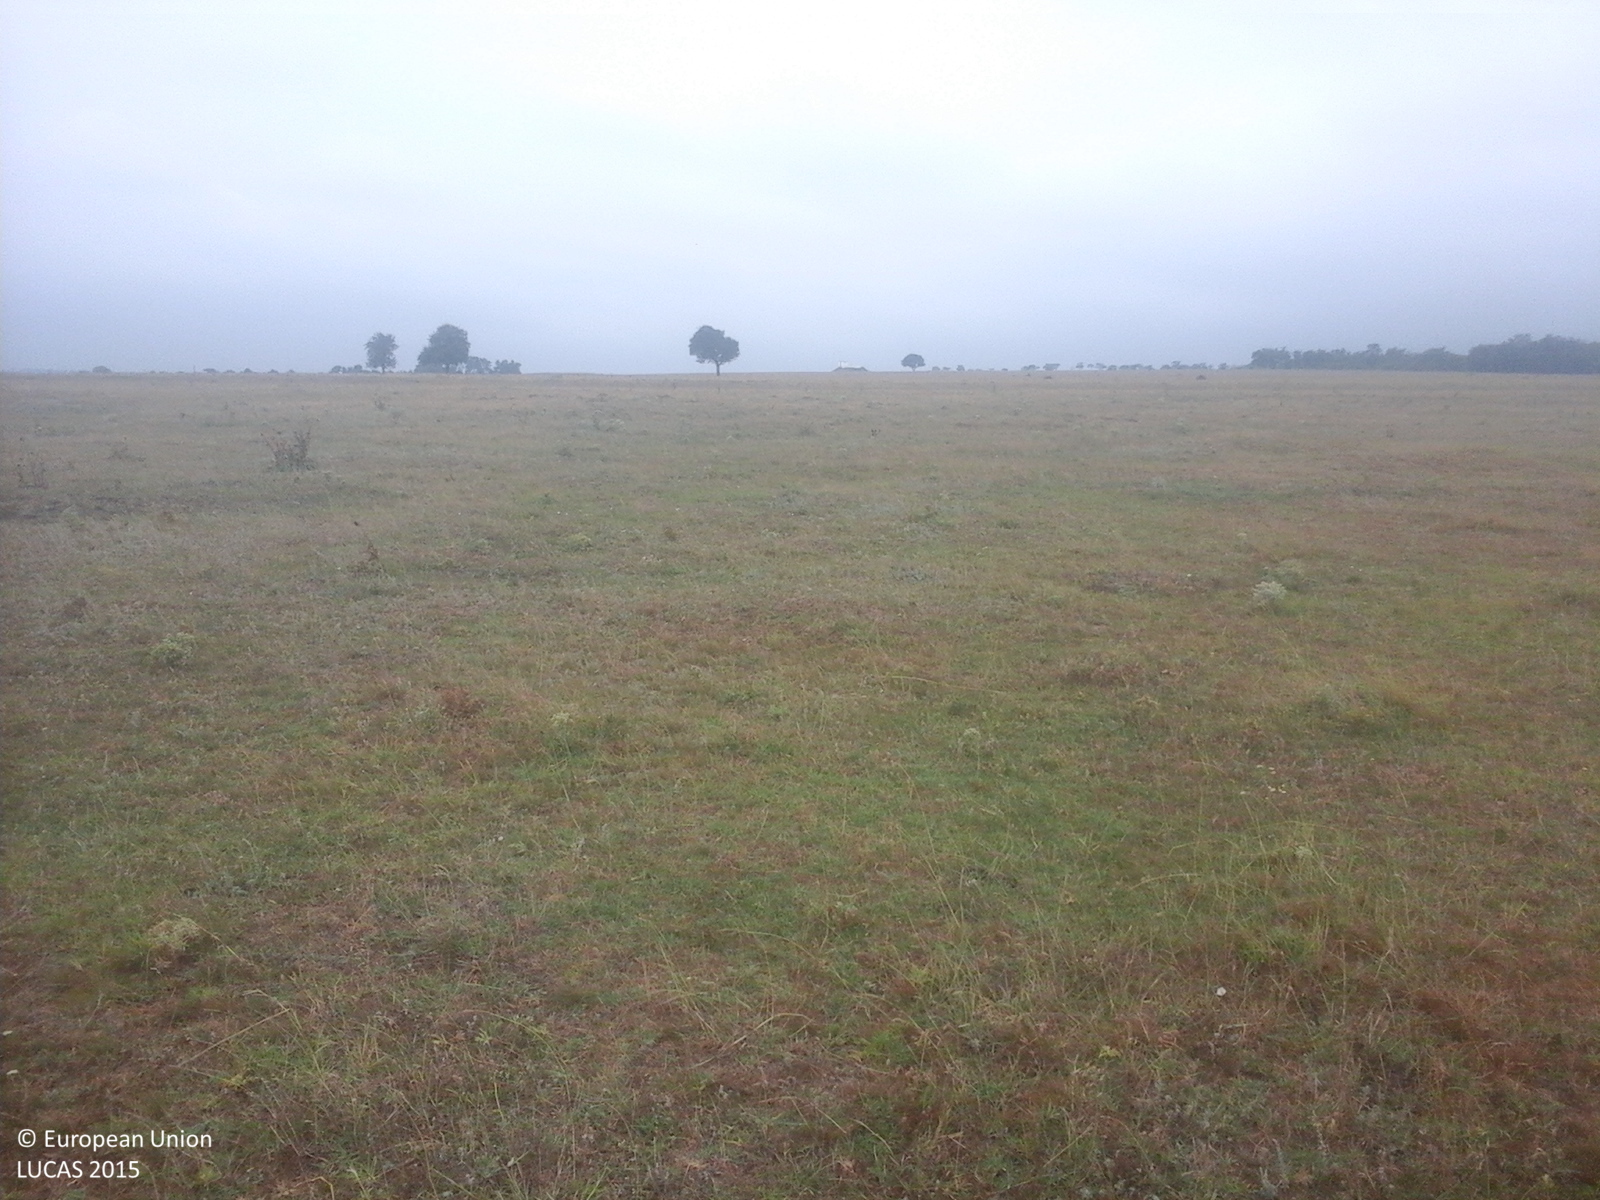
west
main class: Grassland
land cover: Grassland without tree/shrub cover
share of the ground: > 75 %
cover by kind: herbaceous plants 100 %
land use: Agriculture (excluding fallow land and kitchen gardens)
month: August
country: RO
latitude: 44.7680
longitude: 28.4323
